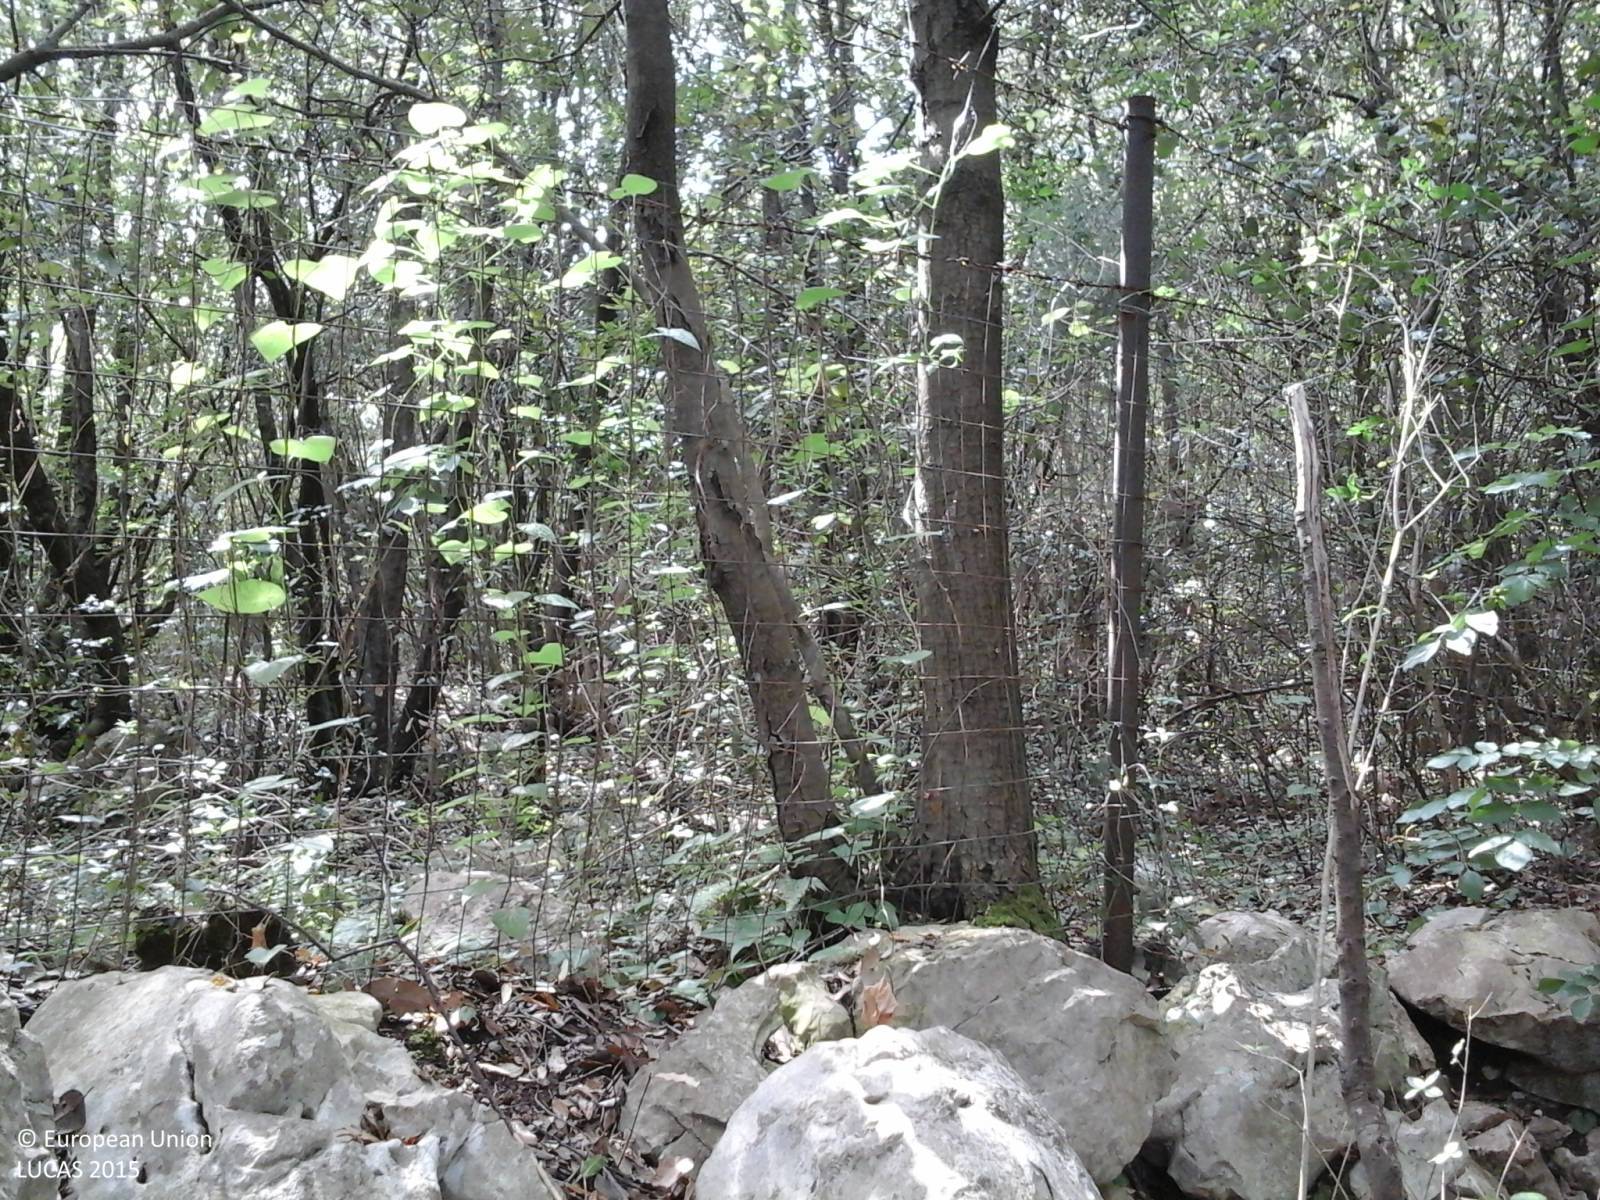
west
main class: Woodland
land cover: Broadleaved woodland
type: thermophilous deciduous forest
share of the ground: > 75 %
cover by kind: broadleaved forest trees 100 %
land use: Forestry
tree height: > 5 m
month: May
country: IT
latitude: 41.2221
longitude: 14.3372
